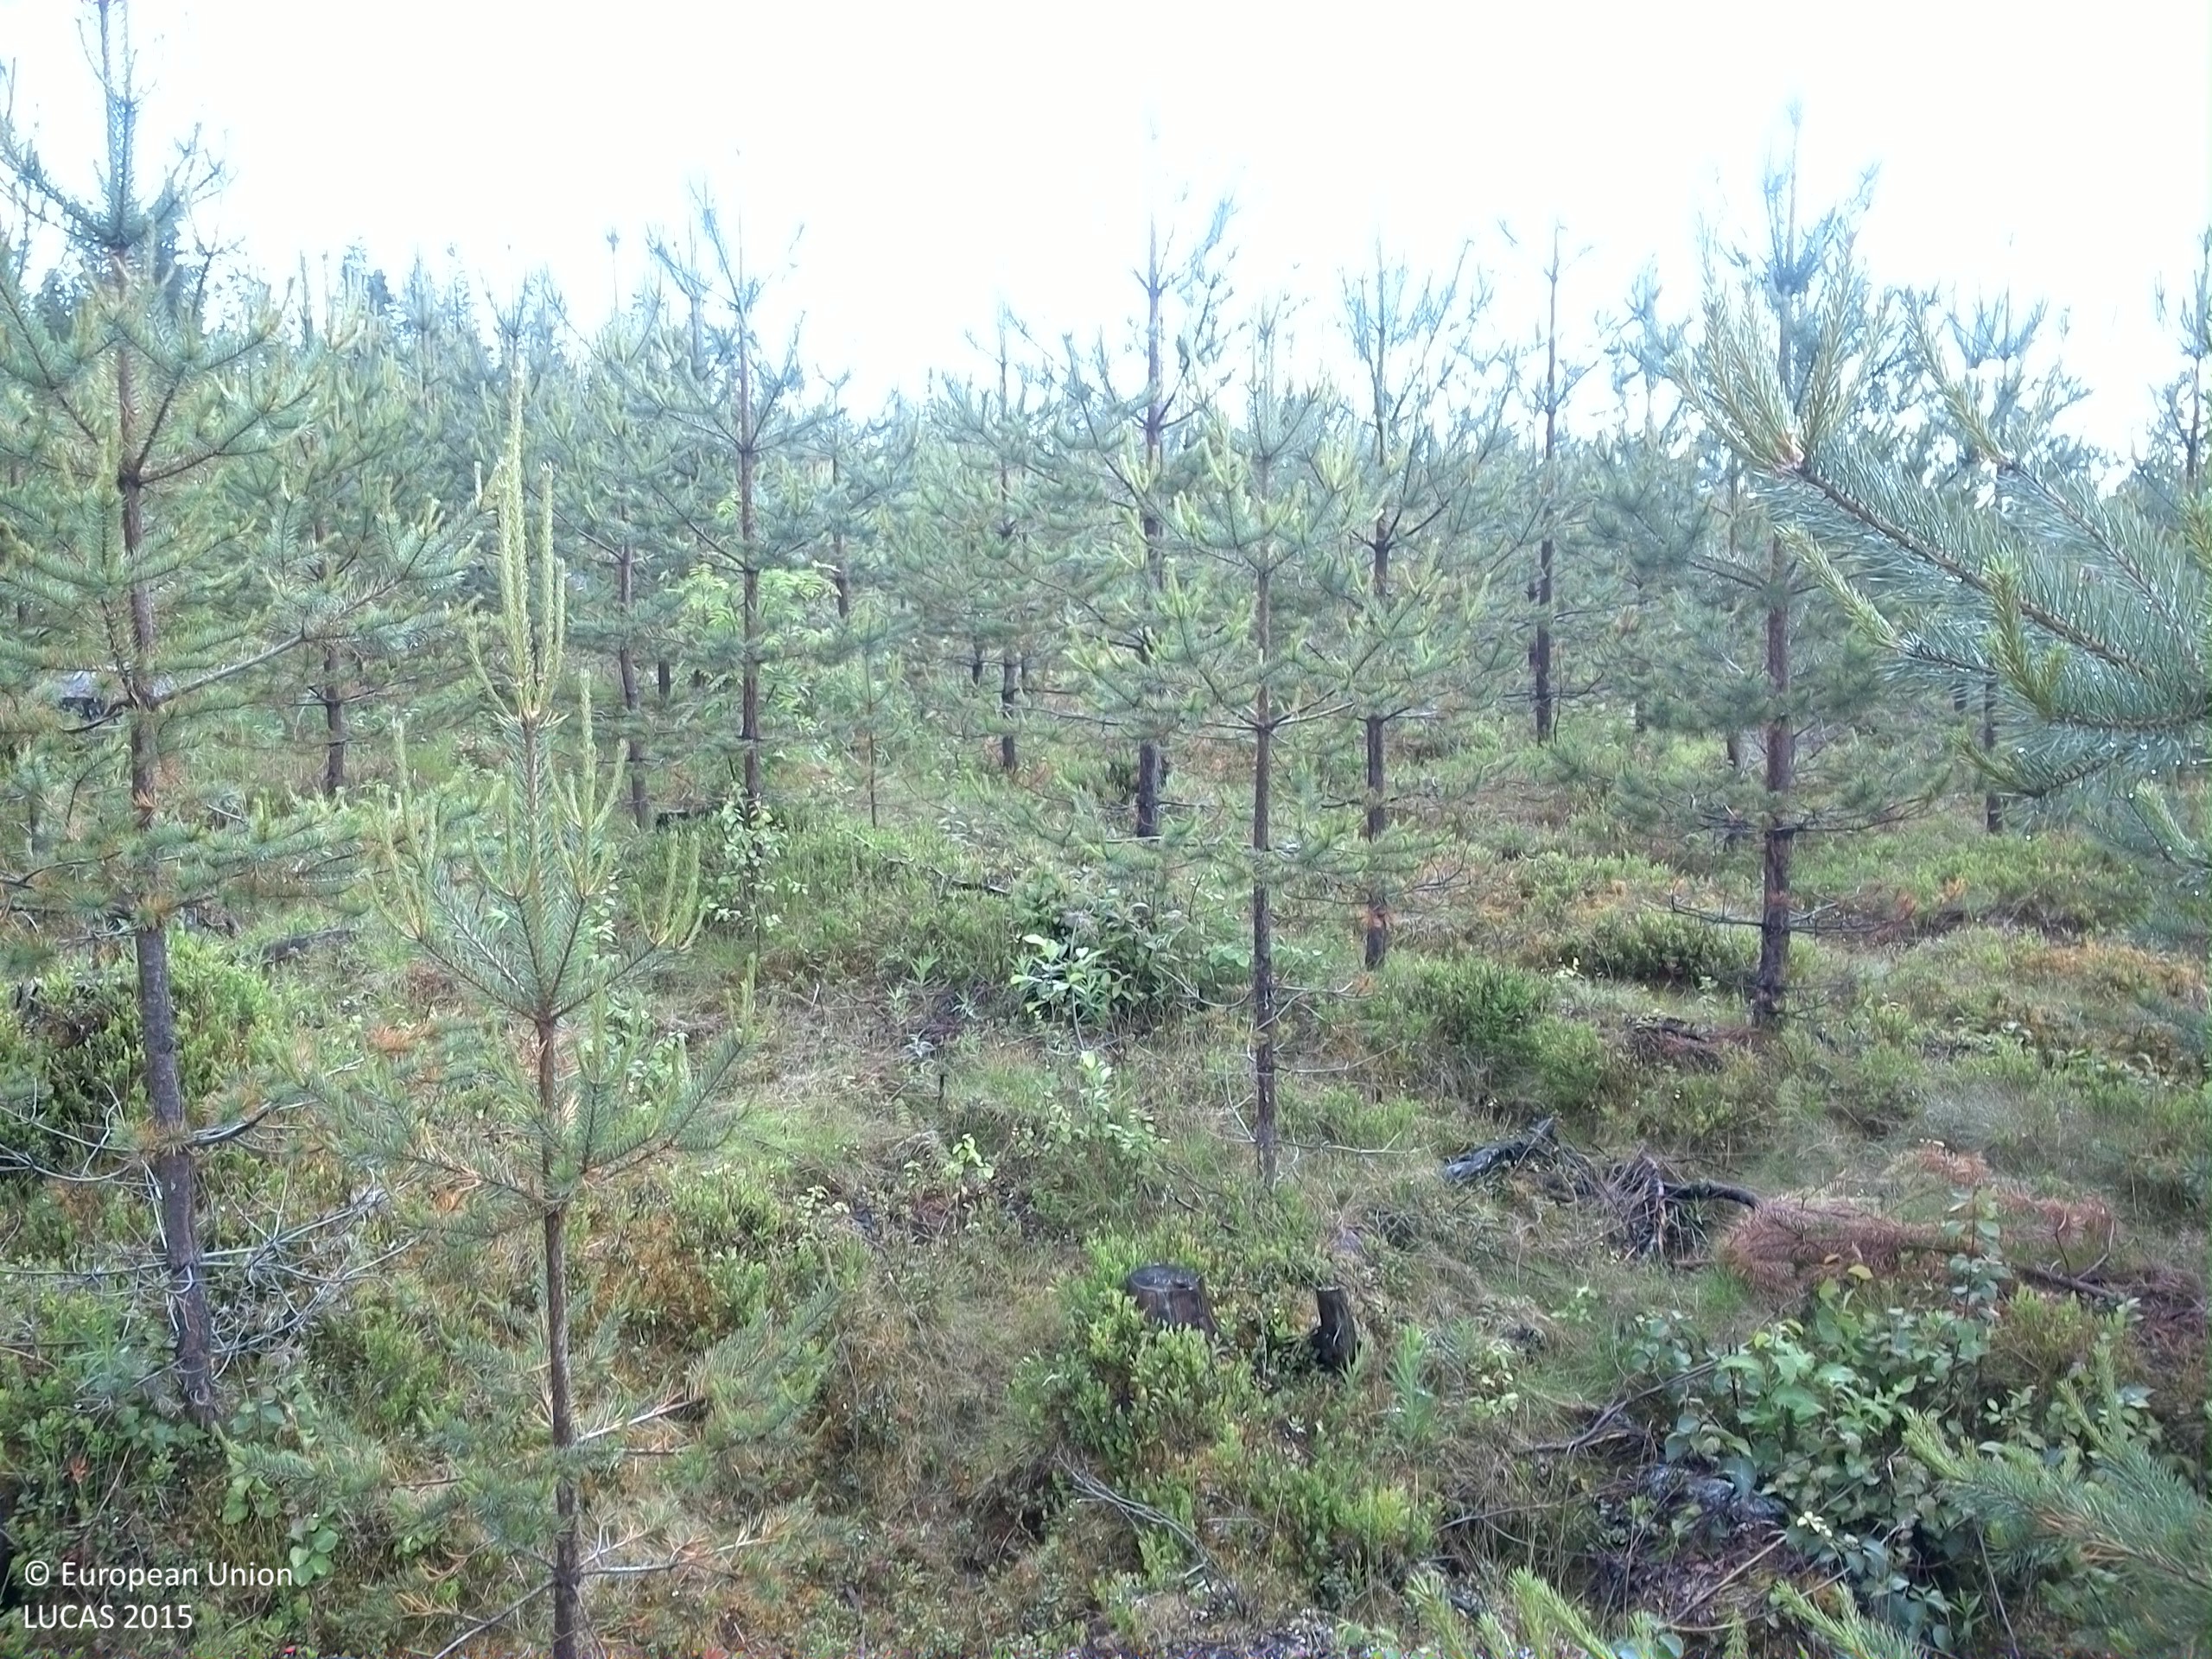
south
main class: Woodland
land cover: Pine dominated coniferous woodland
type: boreal forest
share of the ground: 25 - 50 %
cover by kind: coniferous forest trees 40 %, shrubs 20 %, herbaceous plants 20 %, lichens and mosses 15 %, broadleaved forest trees 5 %
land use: Forestry
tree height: < 5 m
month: July
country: SE
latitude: 63.6156
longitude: 18.6686
